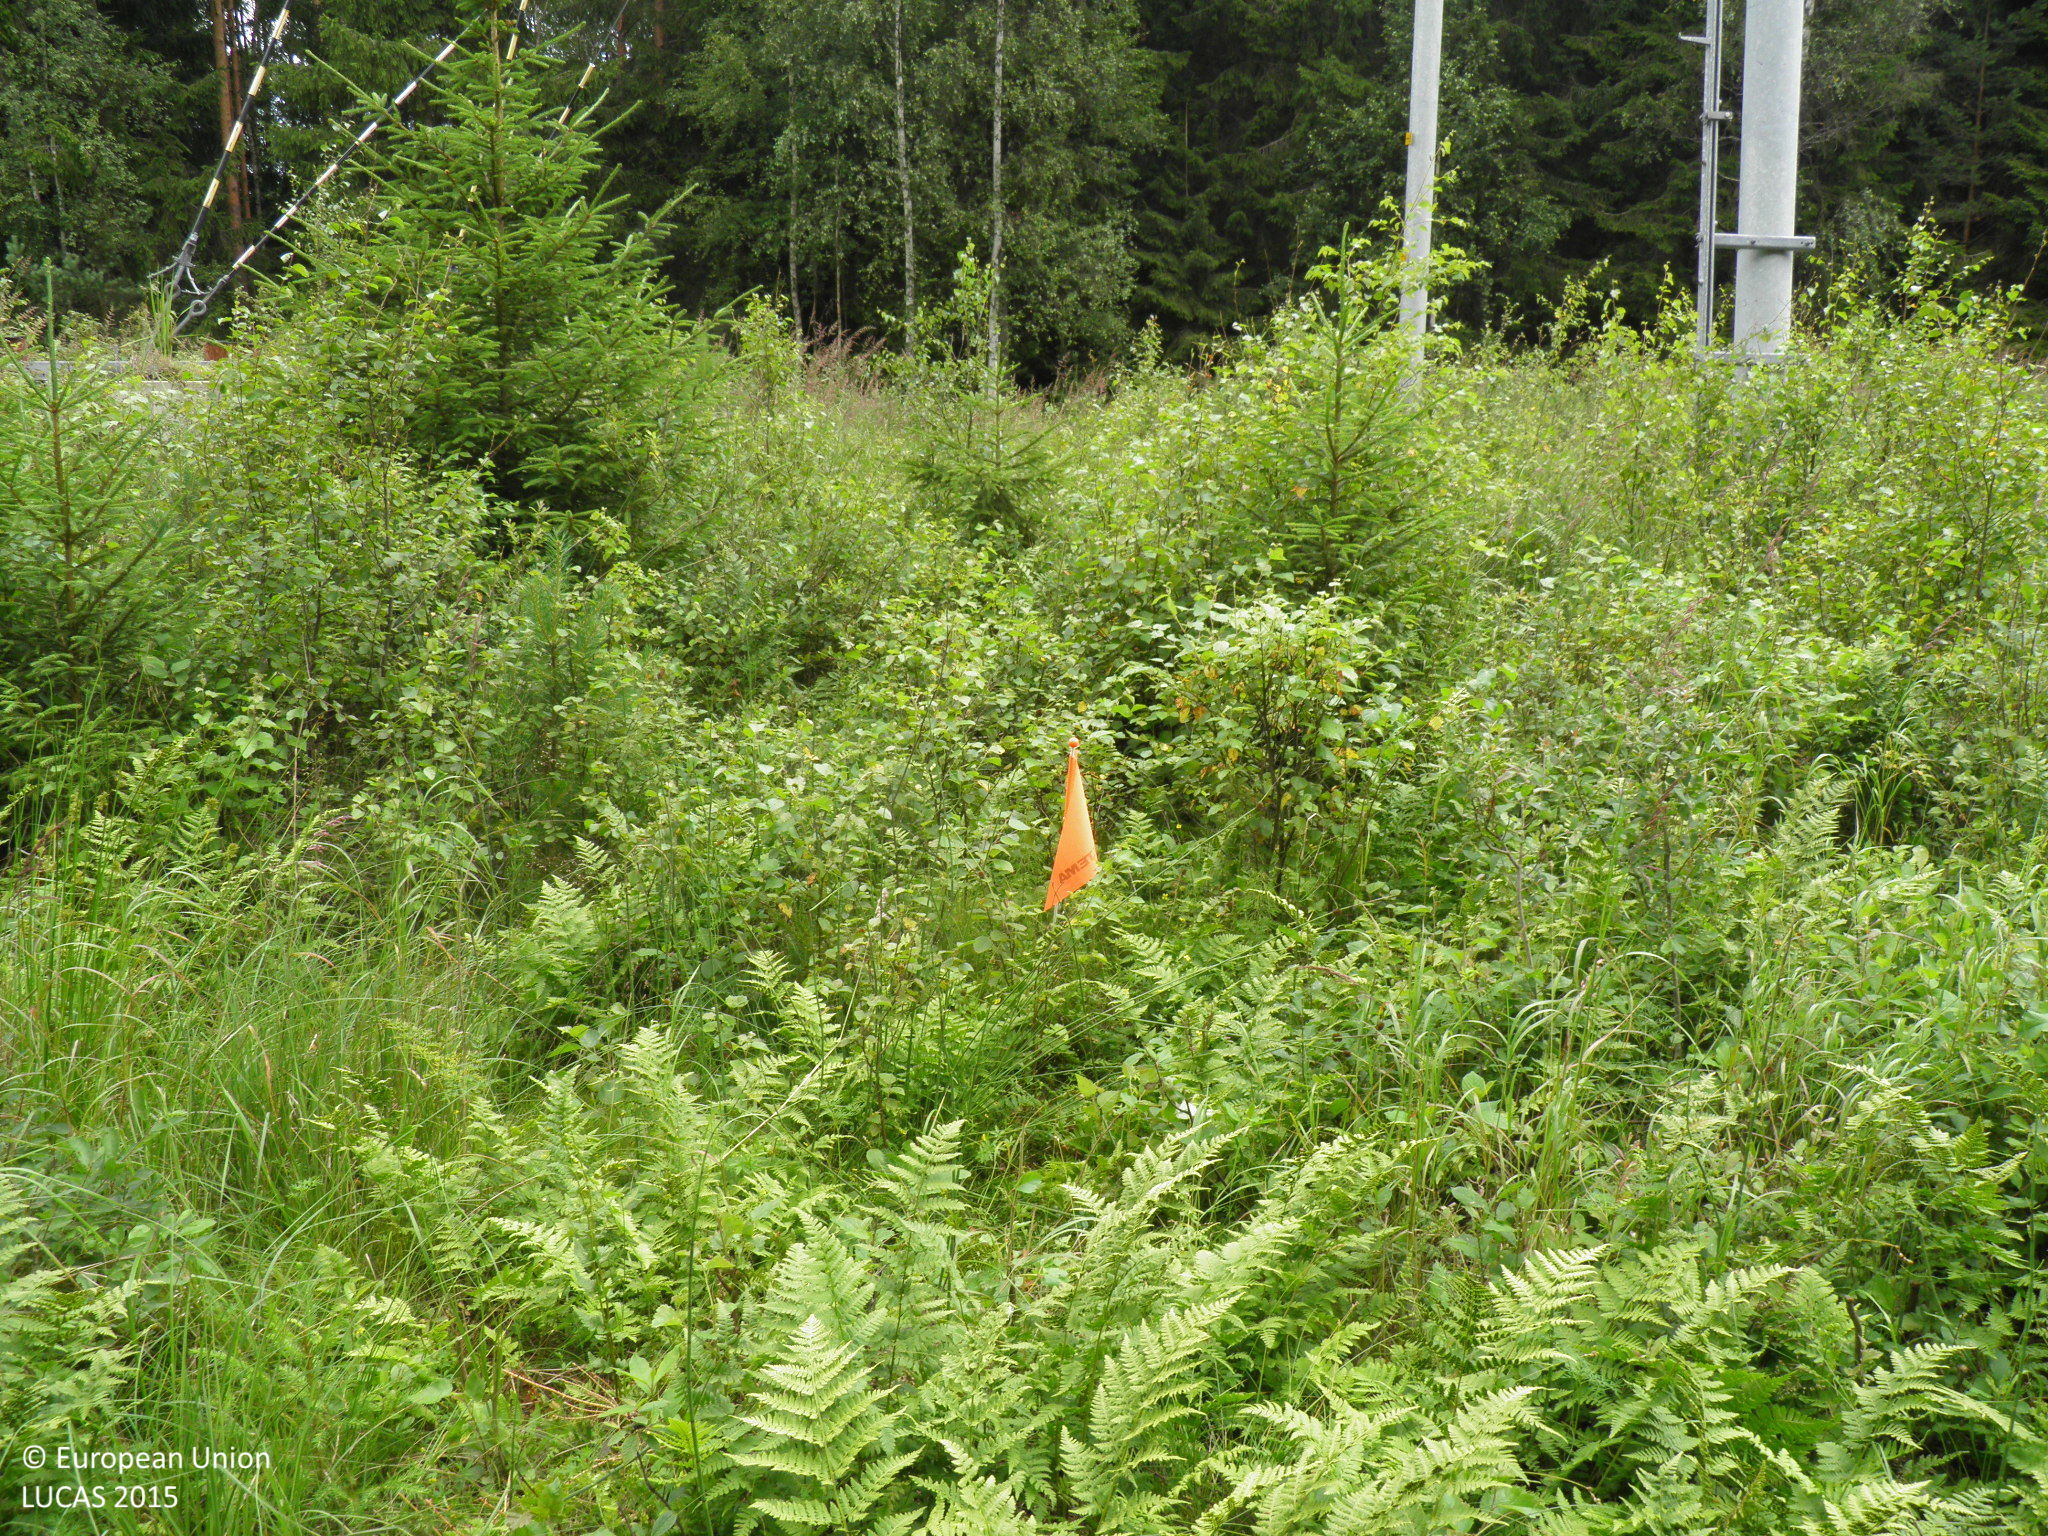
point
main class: Artificial land
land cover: Other artificial areas
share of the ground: > 75 %
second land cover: Shrubland with sparse tree cover
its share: > 75 %
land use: Electricity, gas and thermal power distribution
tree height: < 5 m
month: July
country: FI
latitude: 60.2157
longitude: 22.8004
